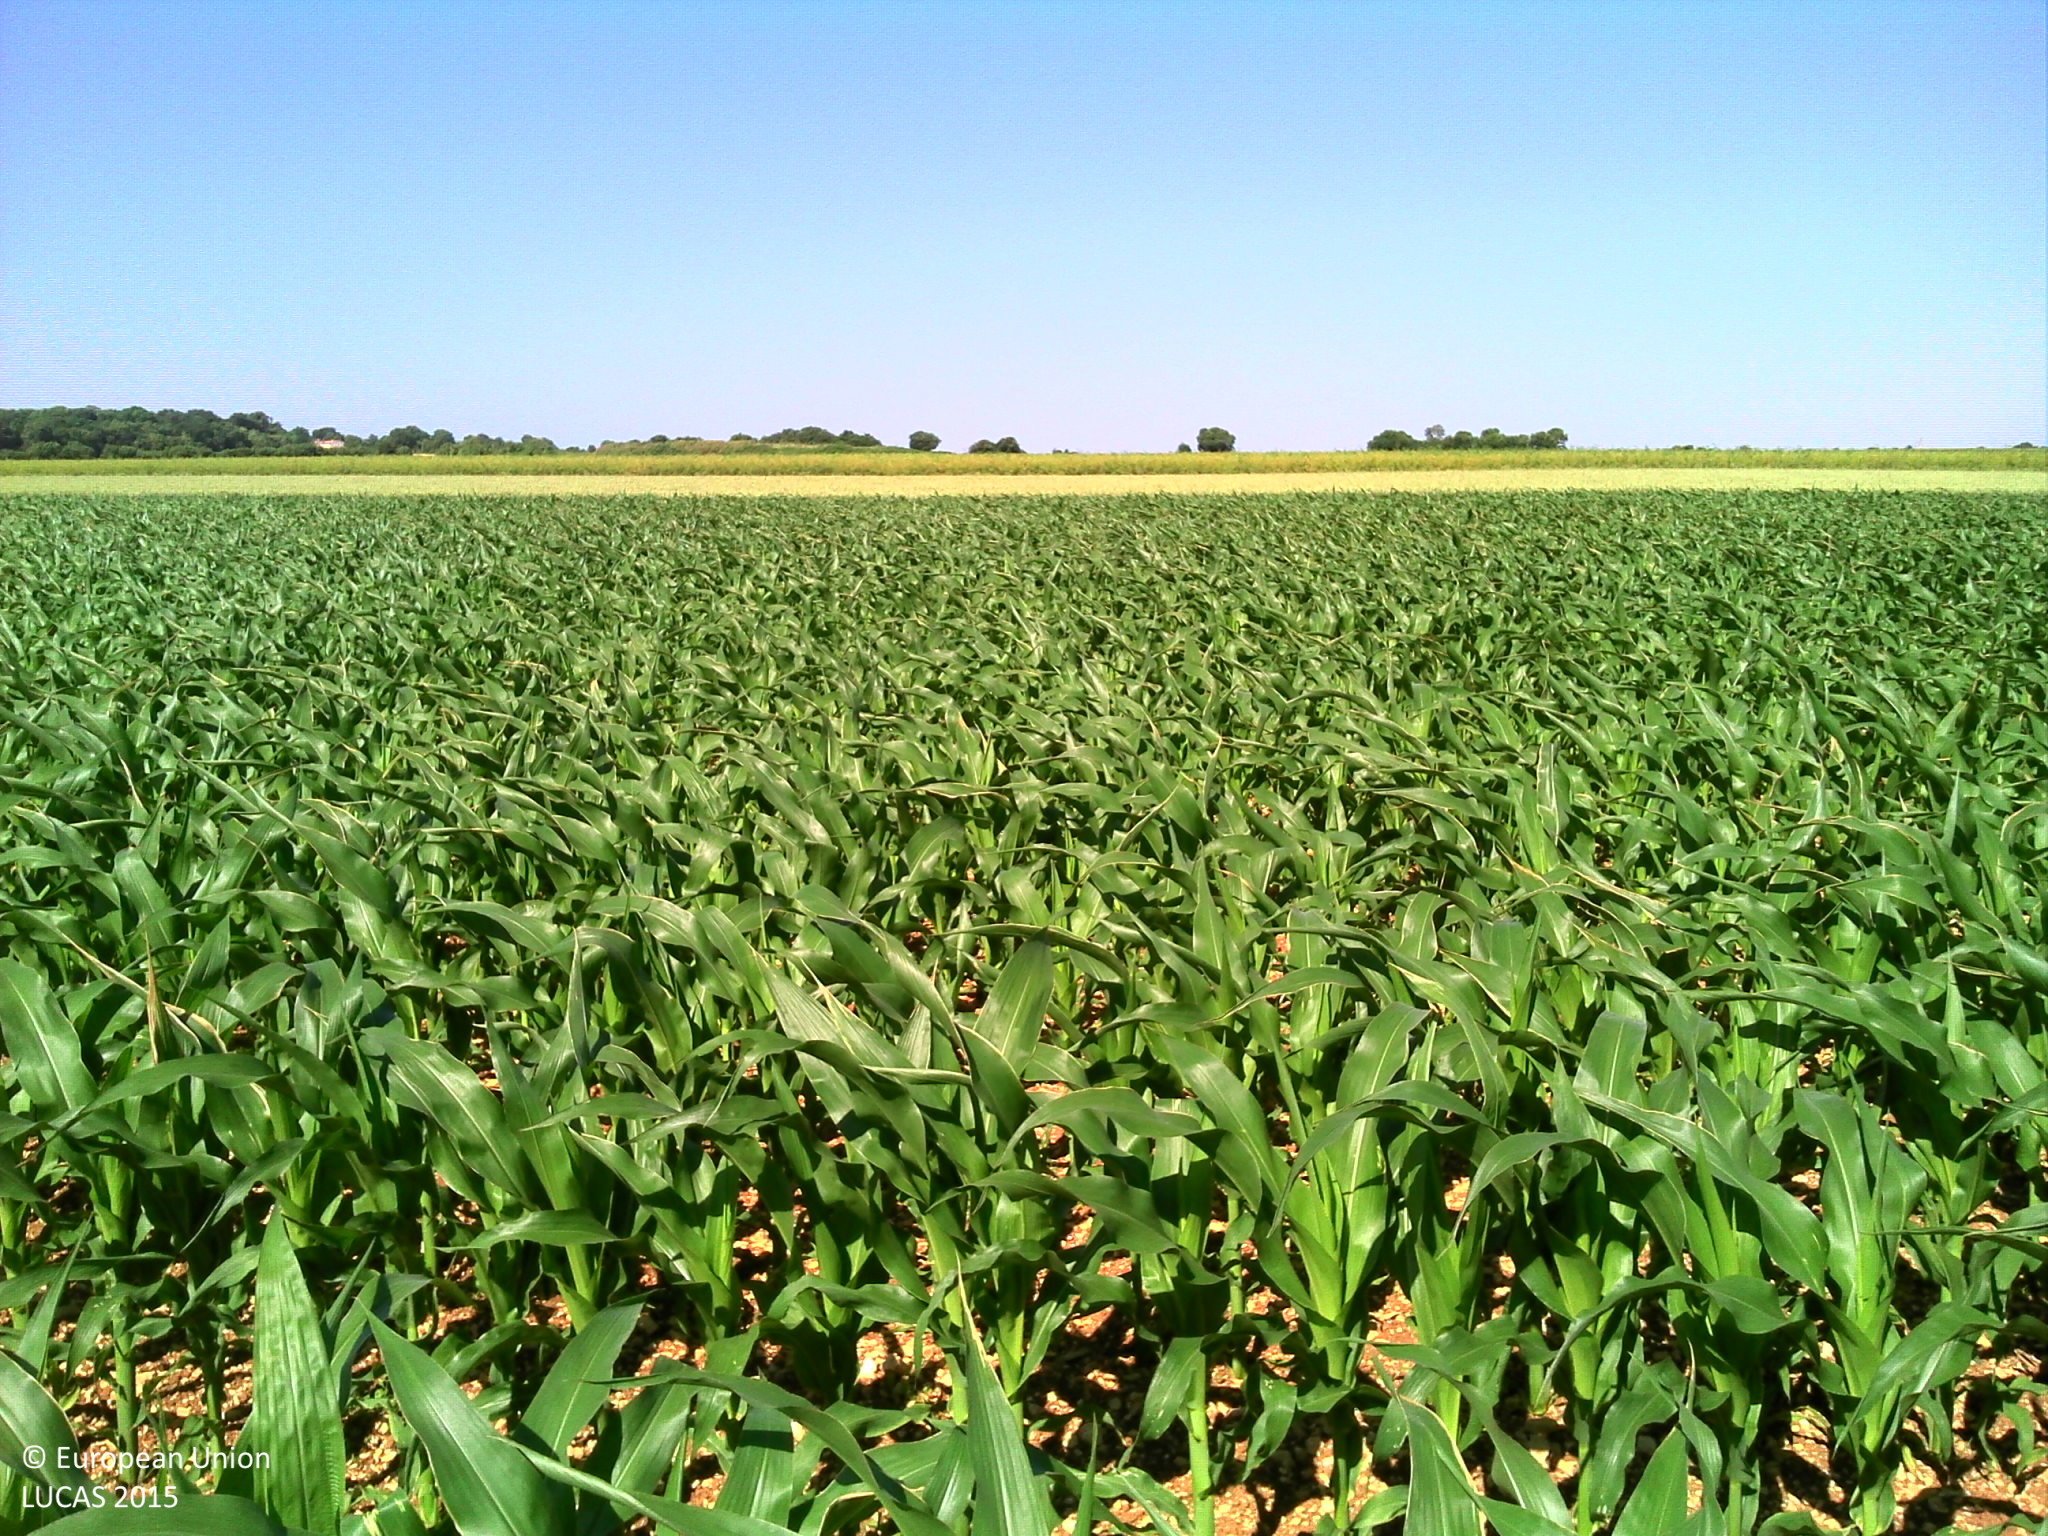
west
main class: Cropland
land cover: Maize
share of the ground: > 75 %
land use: Agriculture (excluding fallow land and kitchen gardens)
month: June
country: FR
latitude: 46.1637
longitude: -0.9994
